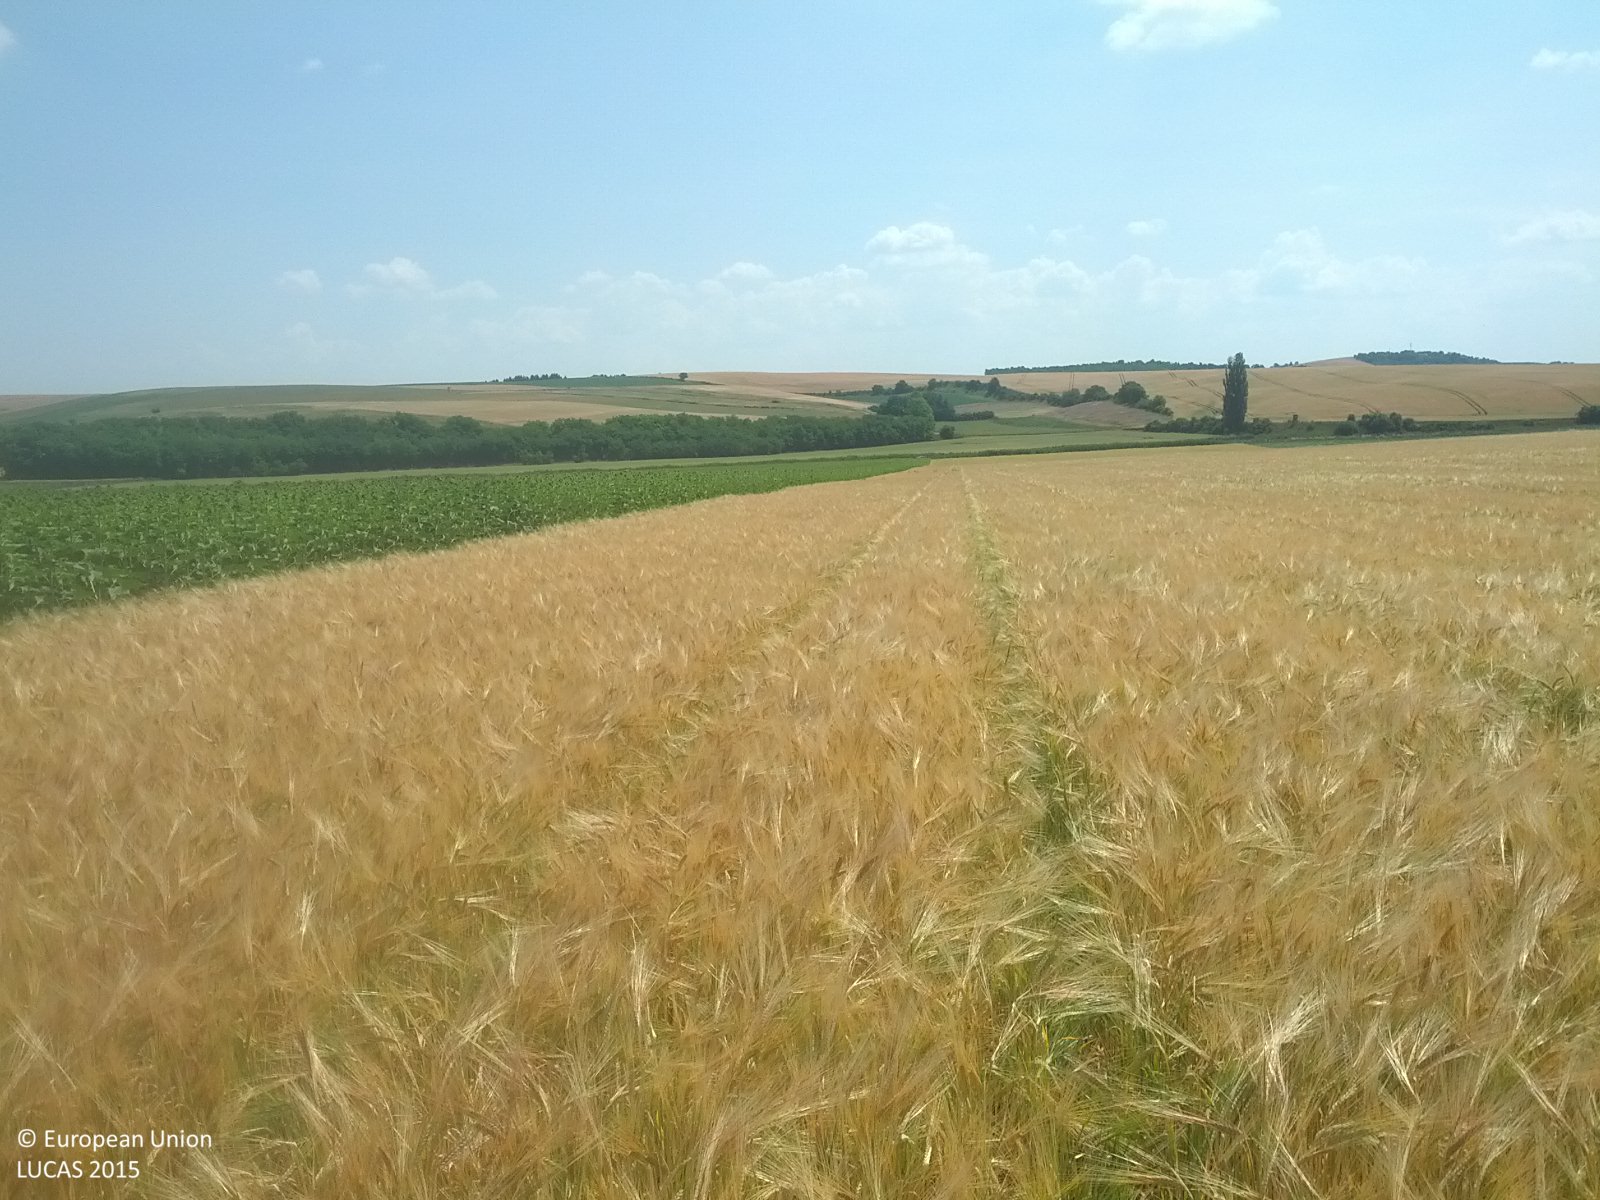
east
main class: Cropland
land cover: Barley
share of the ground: > 75 %
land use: Agriculture (excluding fallow land and kitchen gardens)
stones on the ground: < 10 %
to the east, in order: Barley; Sunflower
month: July
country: AT
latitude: 48.6662
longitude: 16.7557
